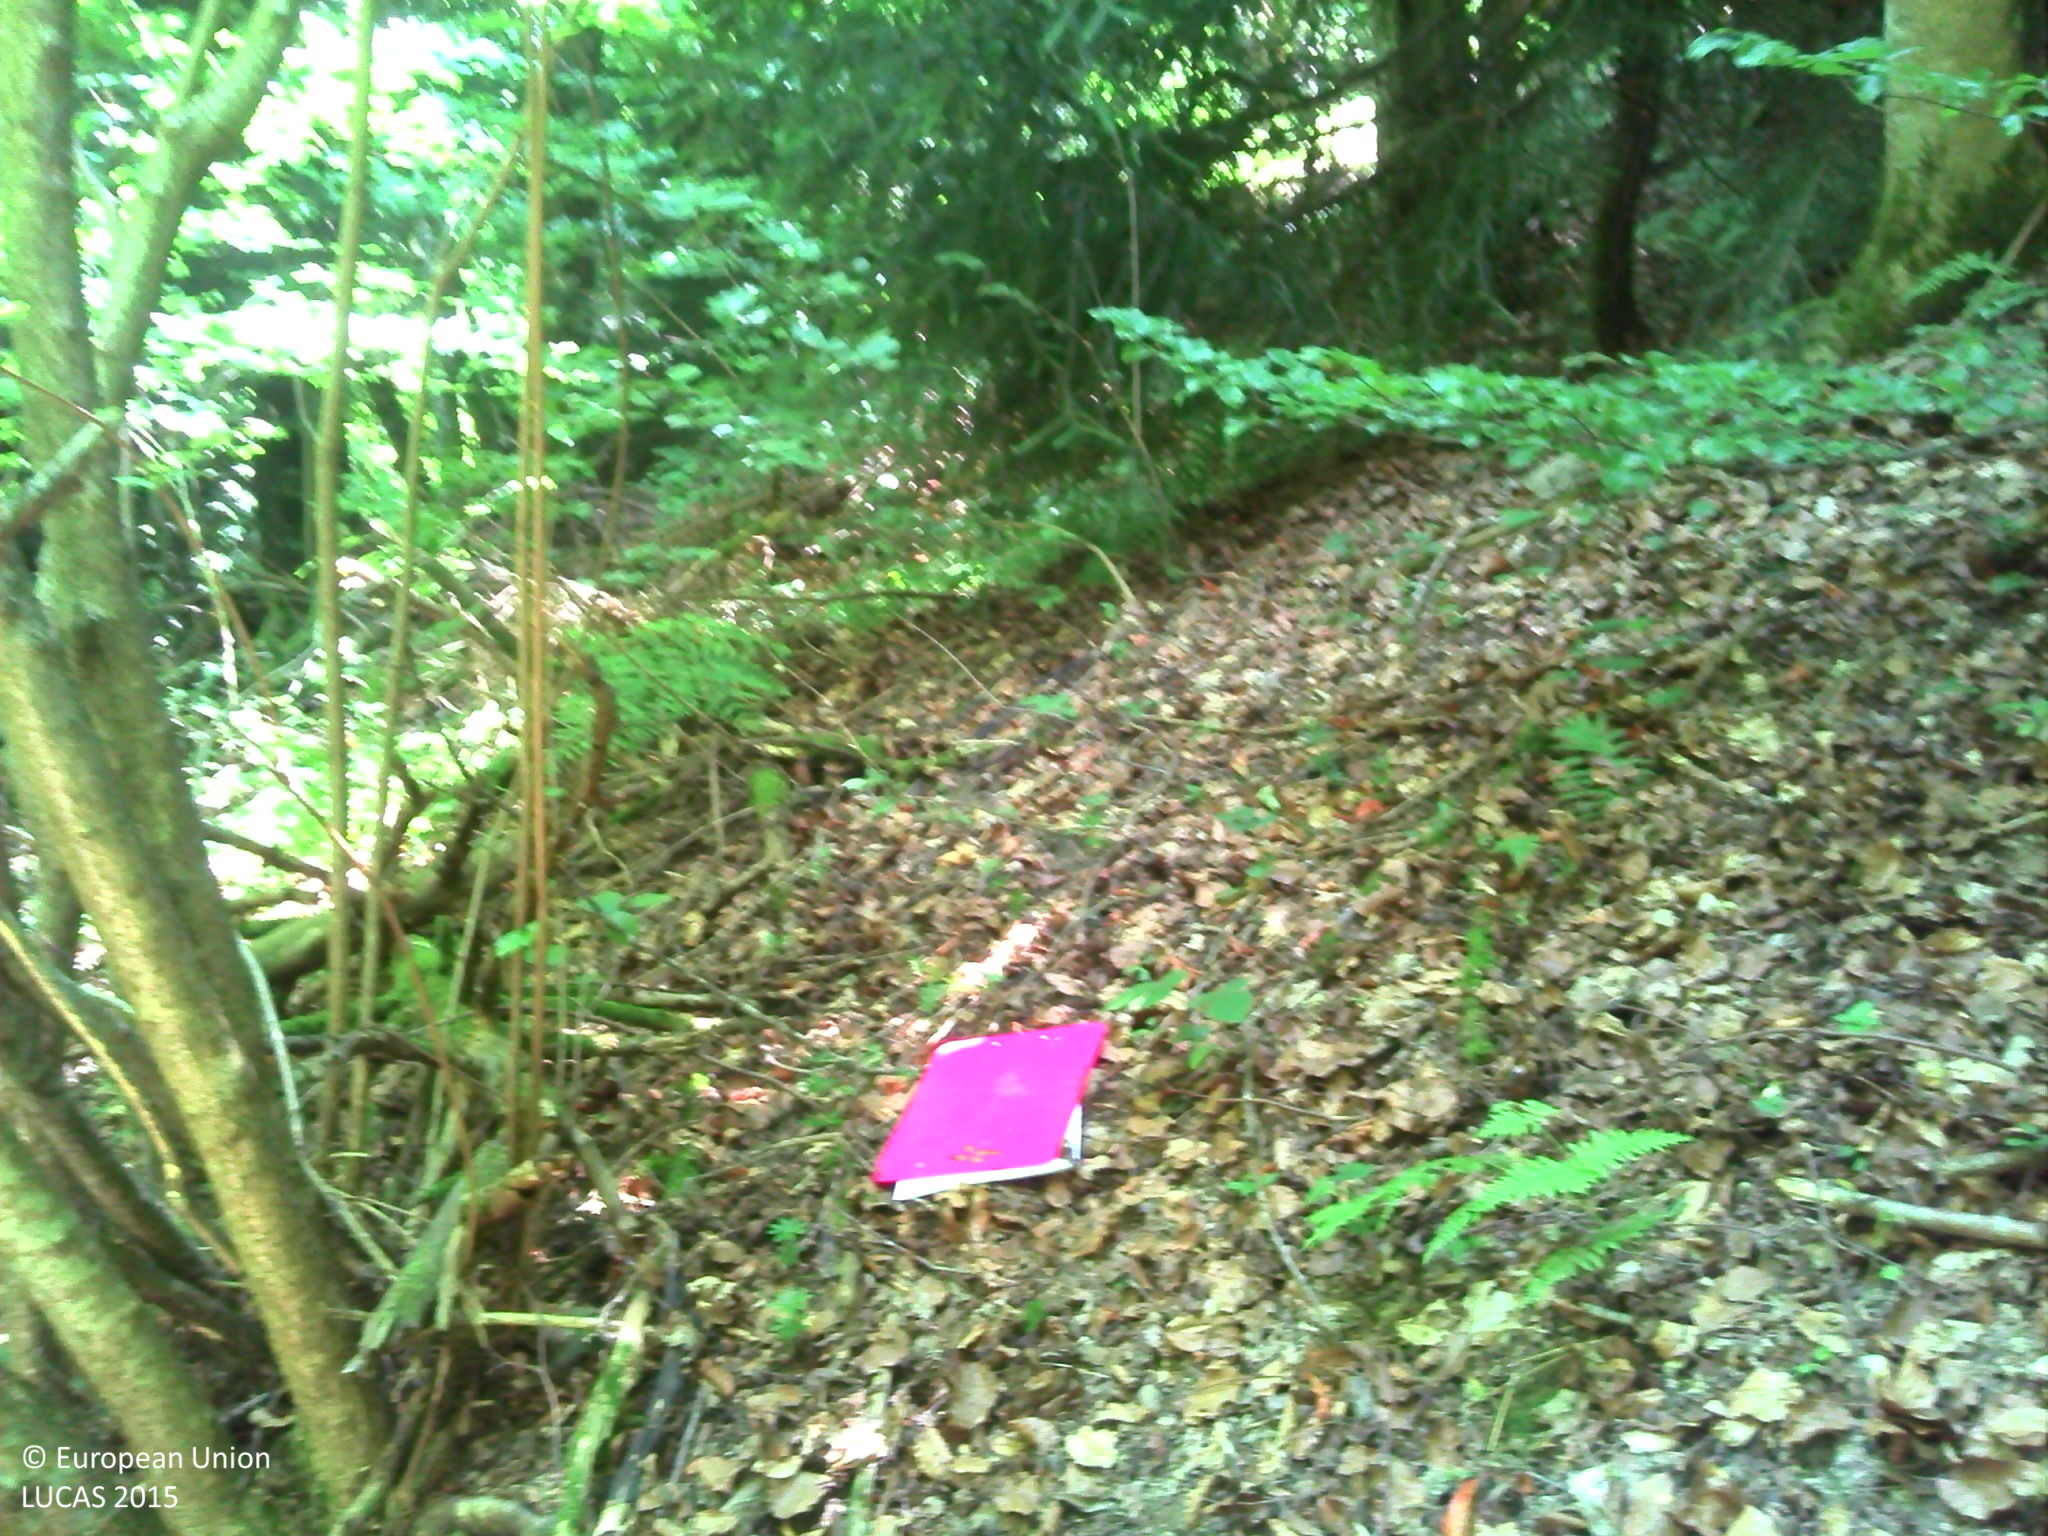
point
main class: Woodland
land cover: Spruce dominated mixed woodland
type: mountainous beech forest
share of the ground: > 75 %
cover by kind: broadleaved forest trees 40 %, coniferous forest trees 35 %, herbaceous plants 20 %, lichens and mosses 5 %
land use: Forestry
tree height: > 5 m
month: July
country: FR
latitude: 45.8871
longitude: 6.2026
